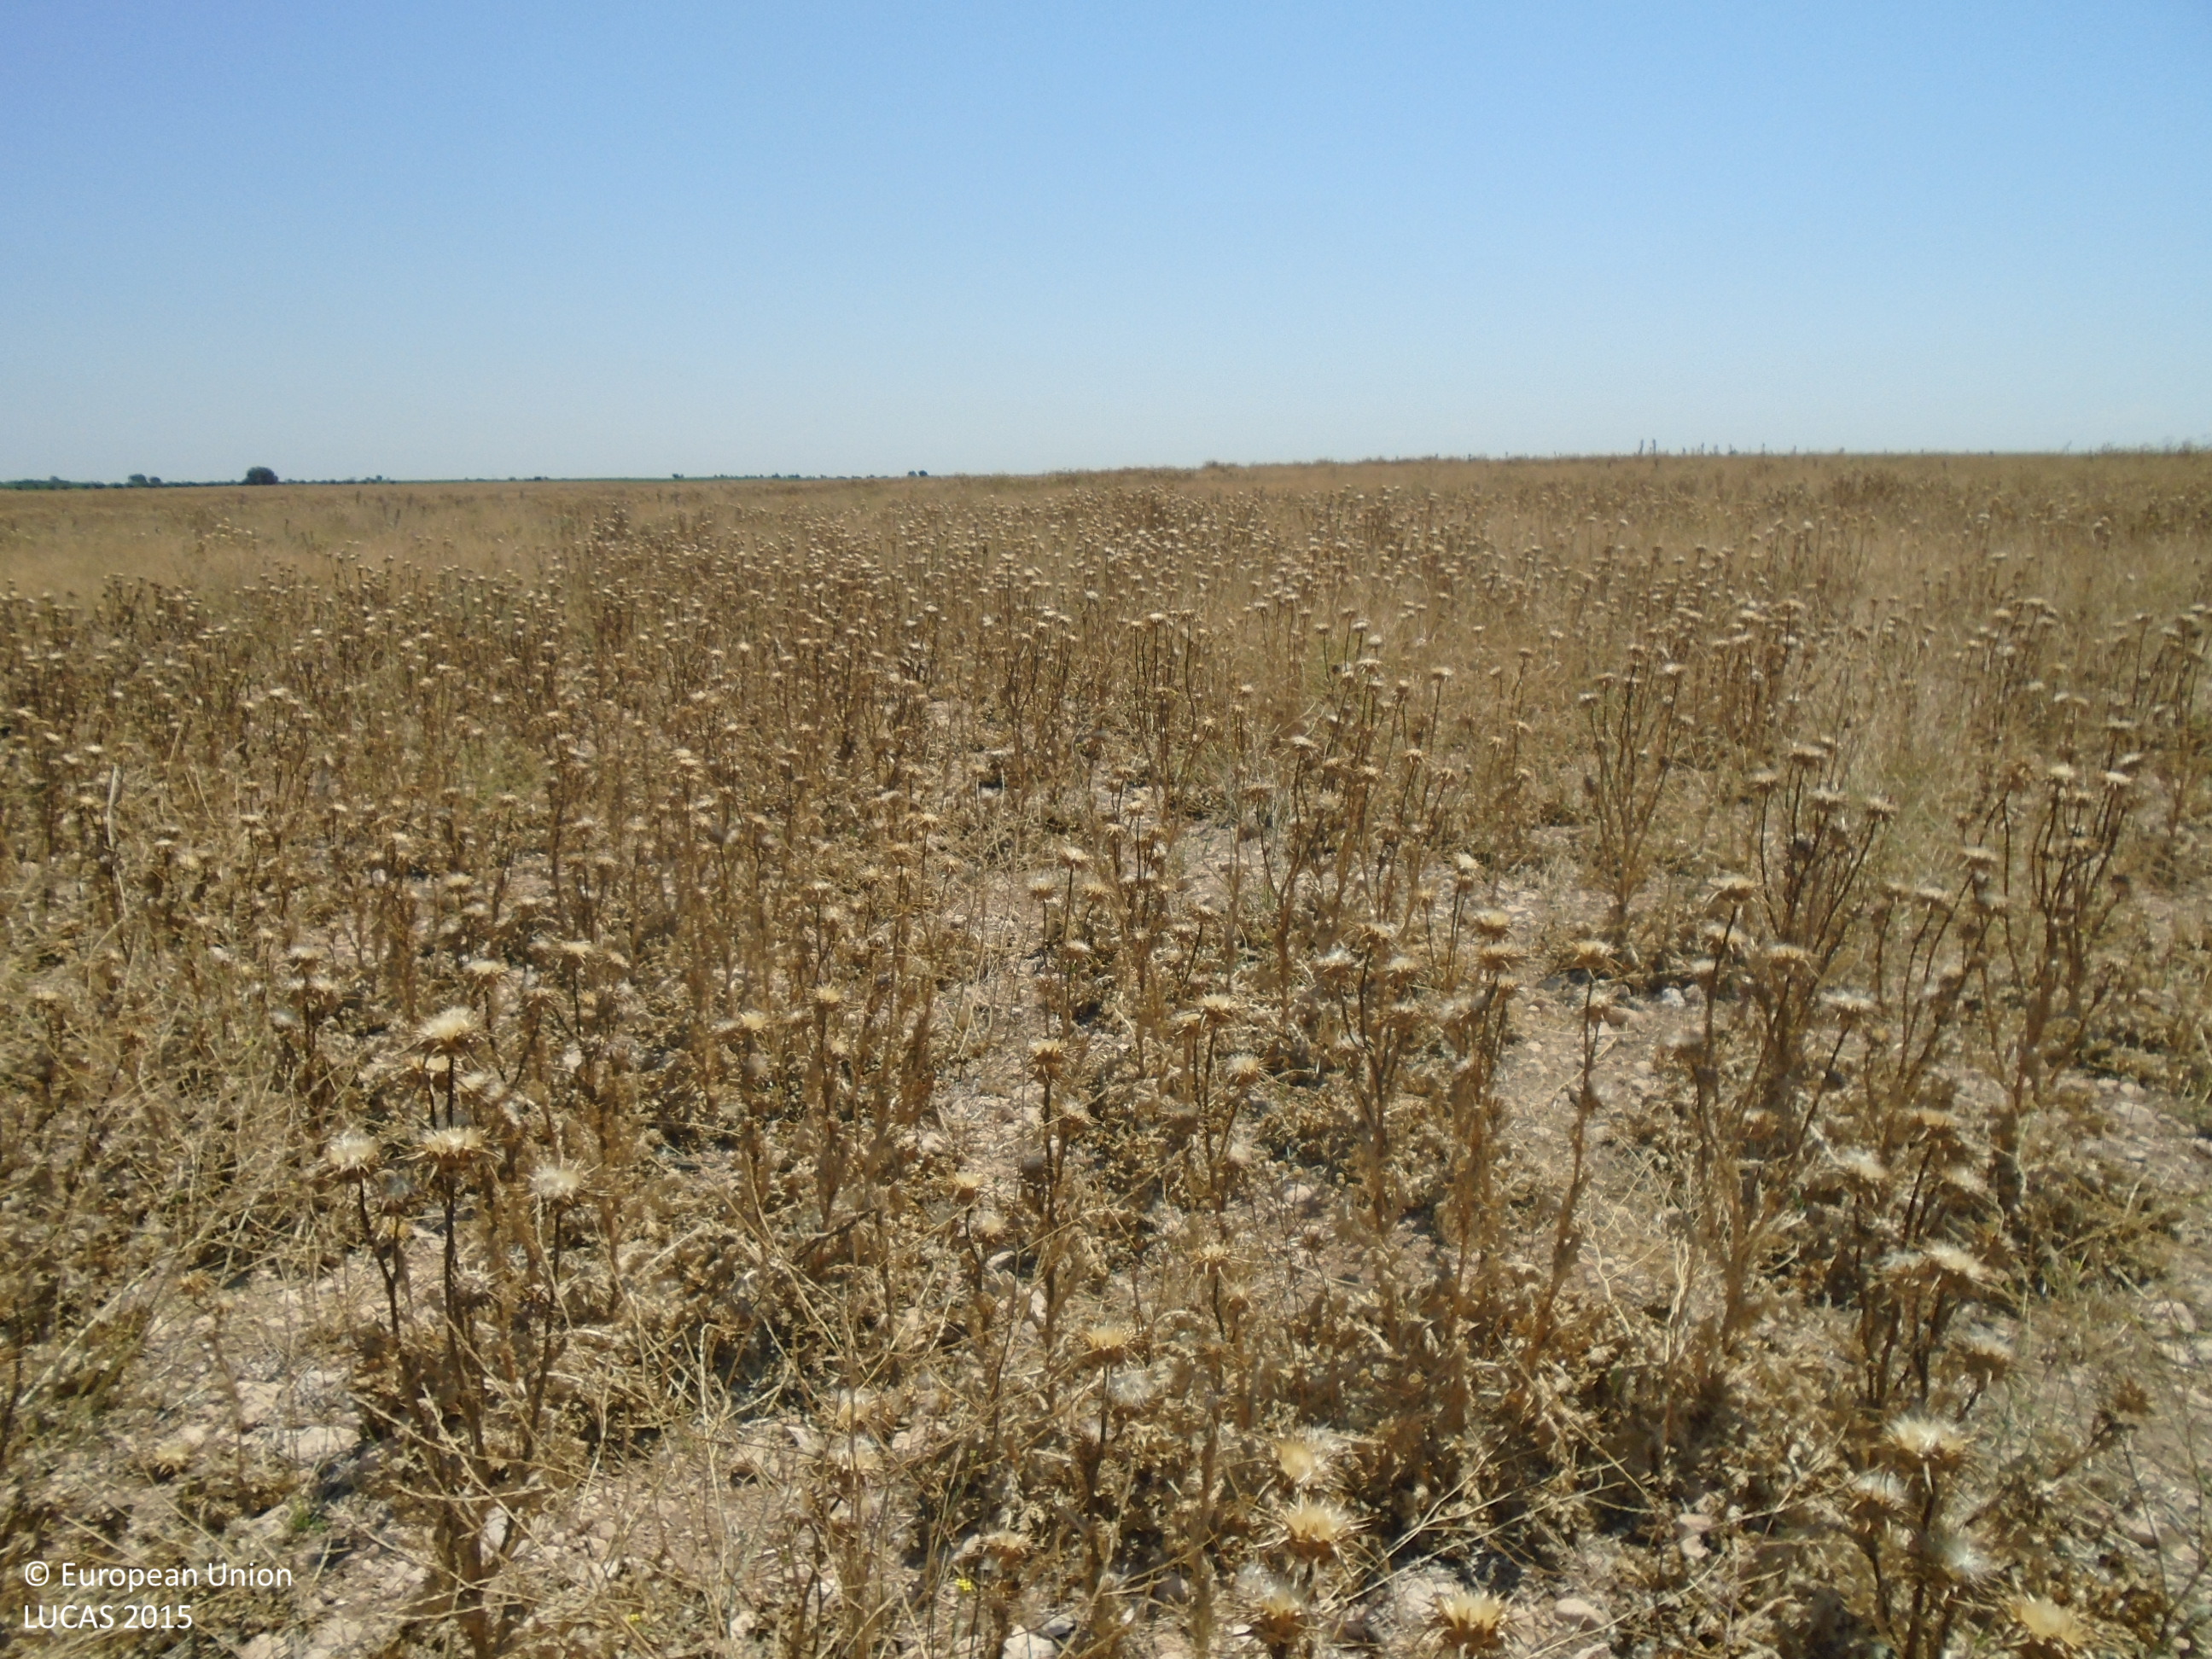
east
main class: Grassland
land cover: Spontaneously vegetated surfaces
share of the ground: > 75 %
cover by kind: herbaceous plants 90 %, consolidated bare surface 5 %, unconsolidated bare surface 5 %
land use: Fallow land
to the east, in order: Spontaneously vegetated surfaces
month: June
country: ES
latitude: 39.1420
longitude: -3.6604
